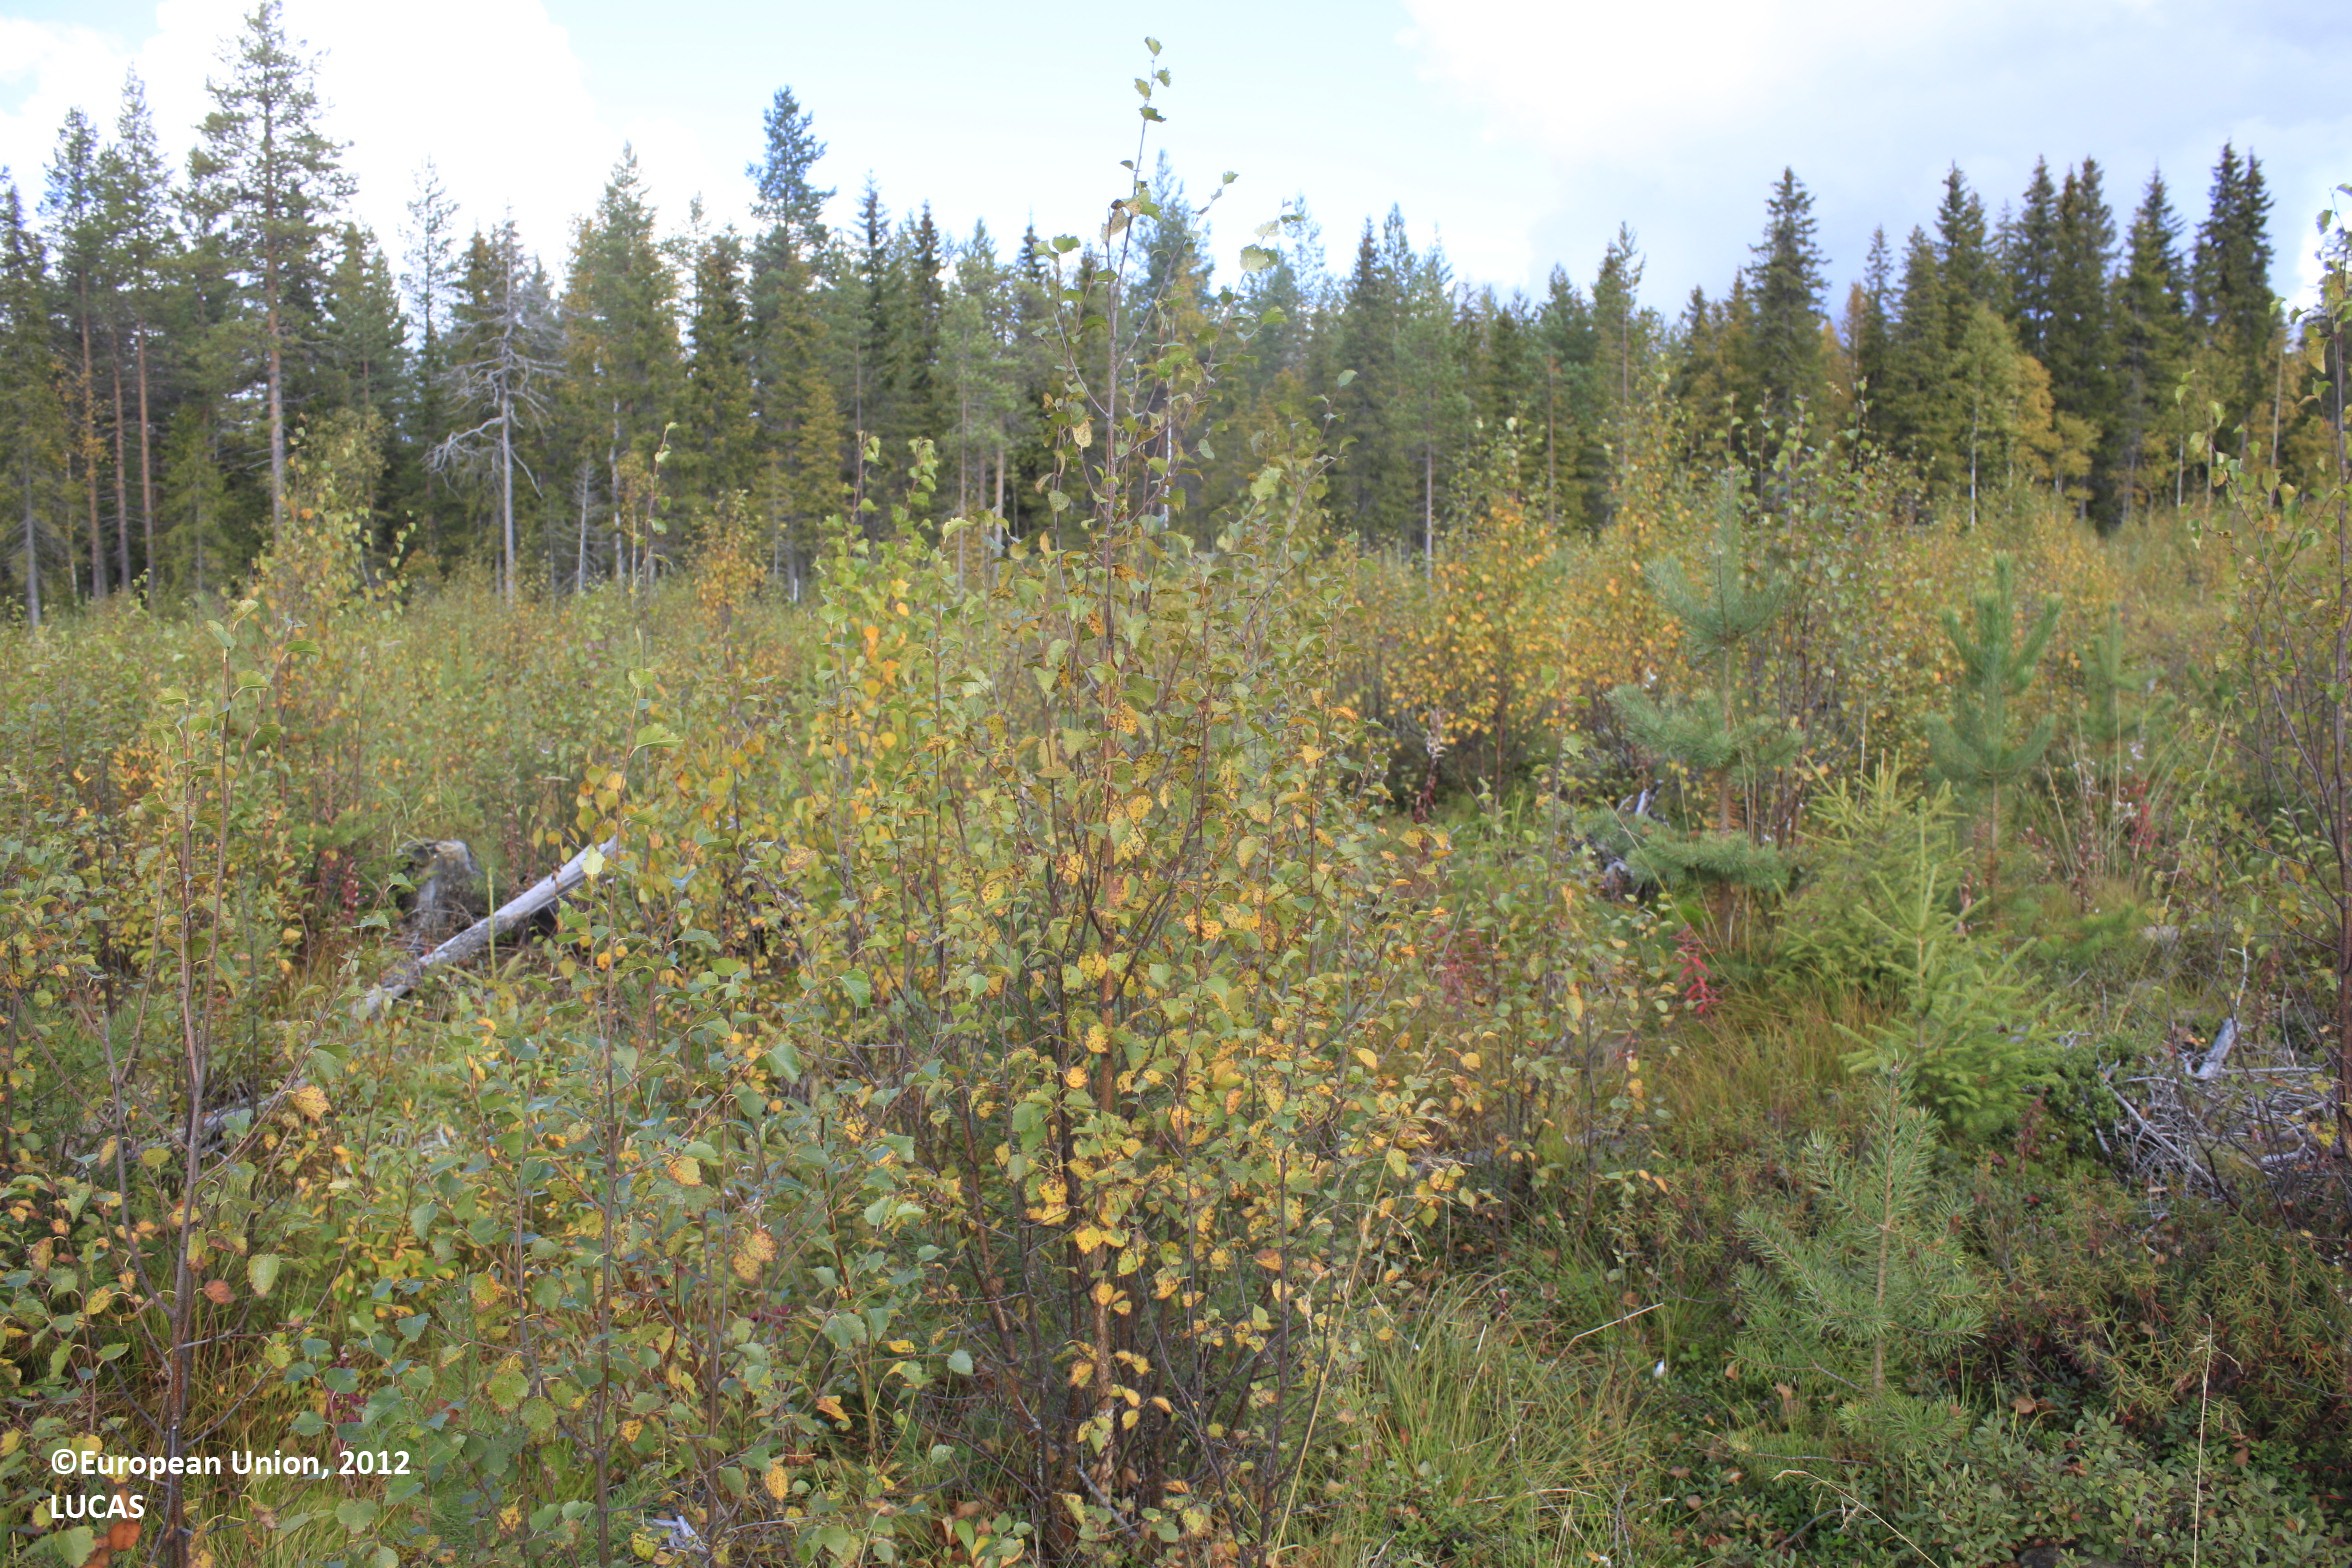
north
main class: Woodland
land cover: Broadleaved woodland
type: boreal forest
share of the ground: 25 - 50 %
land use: Forestry
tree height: < 5 m
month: September
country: FI
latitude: 65.6496
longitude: 26.5992
